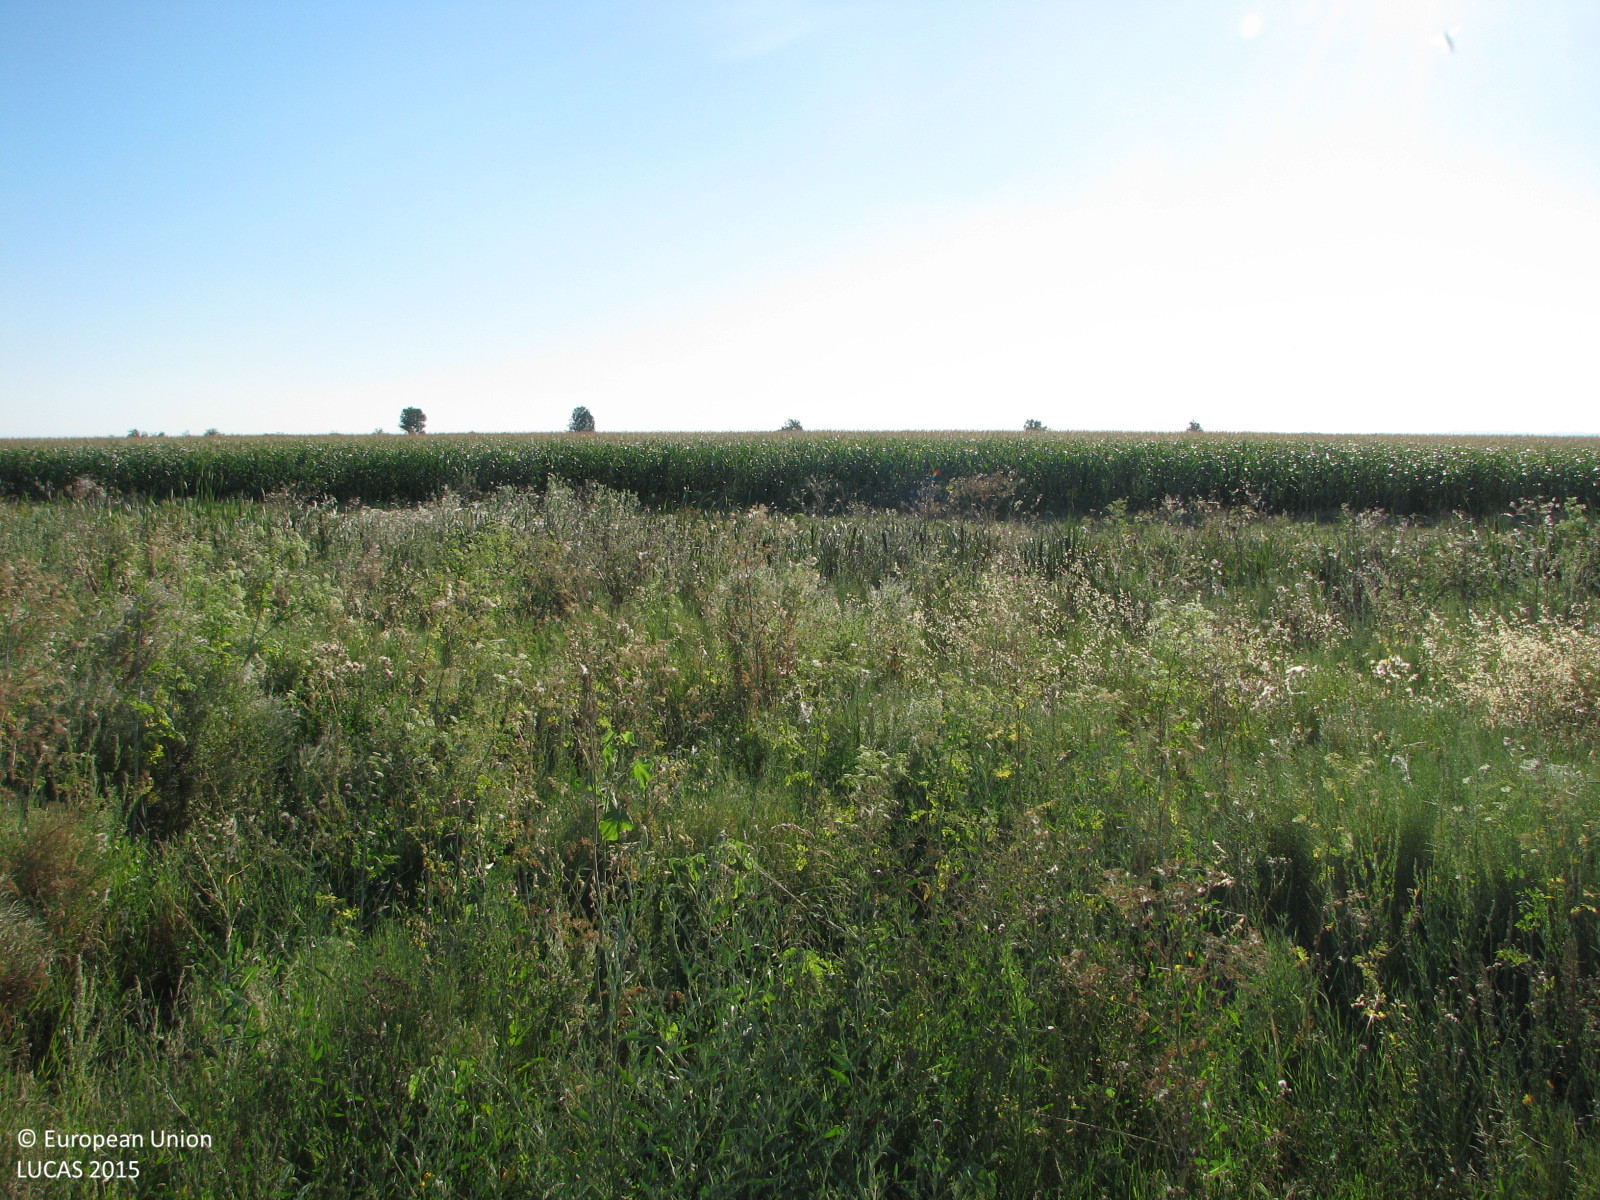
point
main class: Cropland
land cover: Maize
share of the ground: > 75 %
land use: Agriculture (excluding fallow land and kitchen gardens)
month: July
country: BG
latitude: 42.4254
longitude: 25.9645
